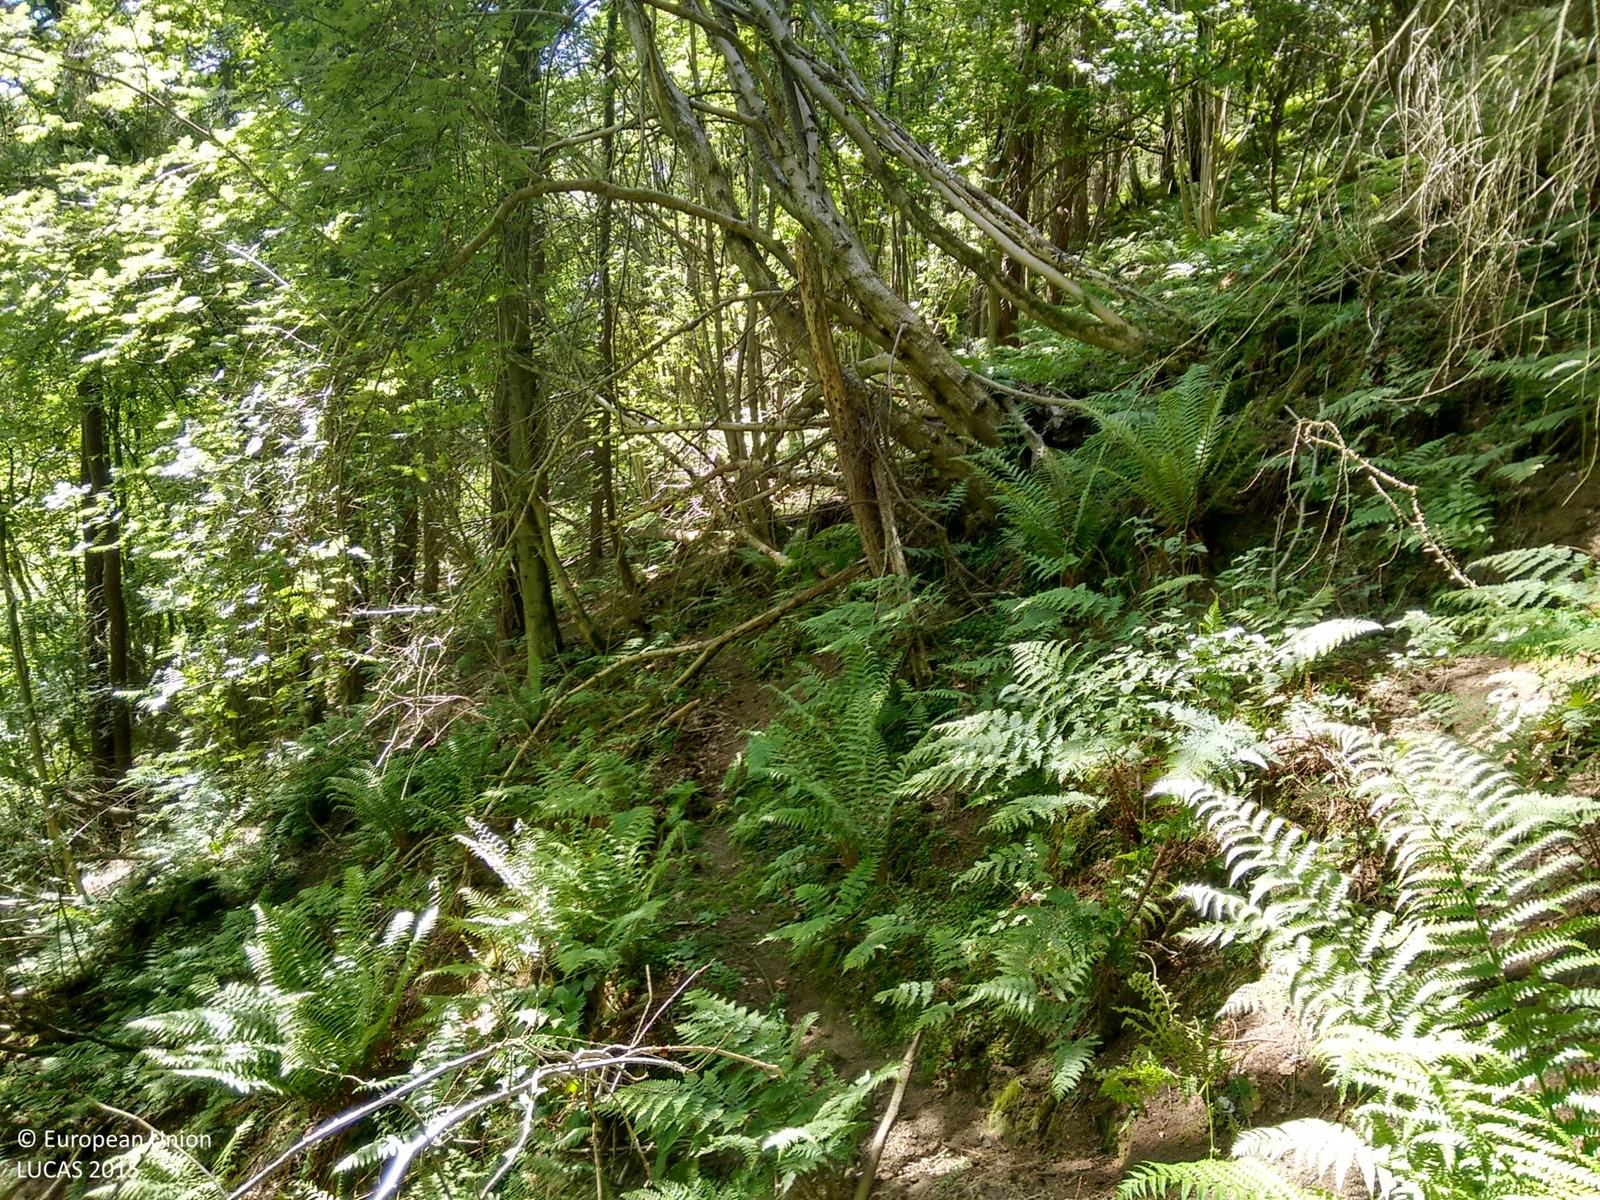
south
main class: Woodland
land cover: Other mixed woodland
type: mesophytic deciduous forest
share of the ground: > 75 %
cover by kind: coniferous forest trees 50 %, broadleaved forest trees 50 %
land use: Sport
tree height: > 5 m
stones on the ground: < 10 %
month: June
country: GB
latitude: 54.2247
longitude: -1.1959
